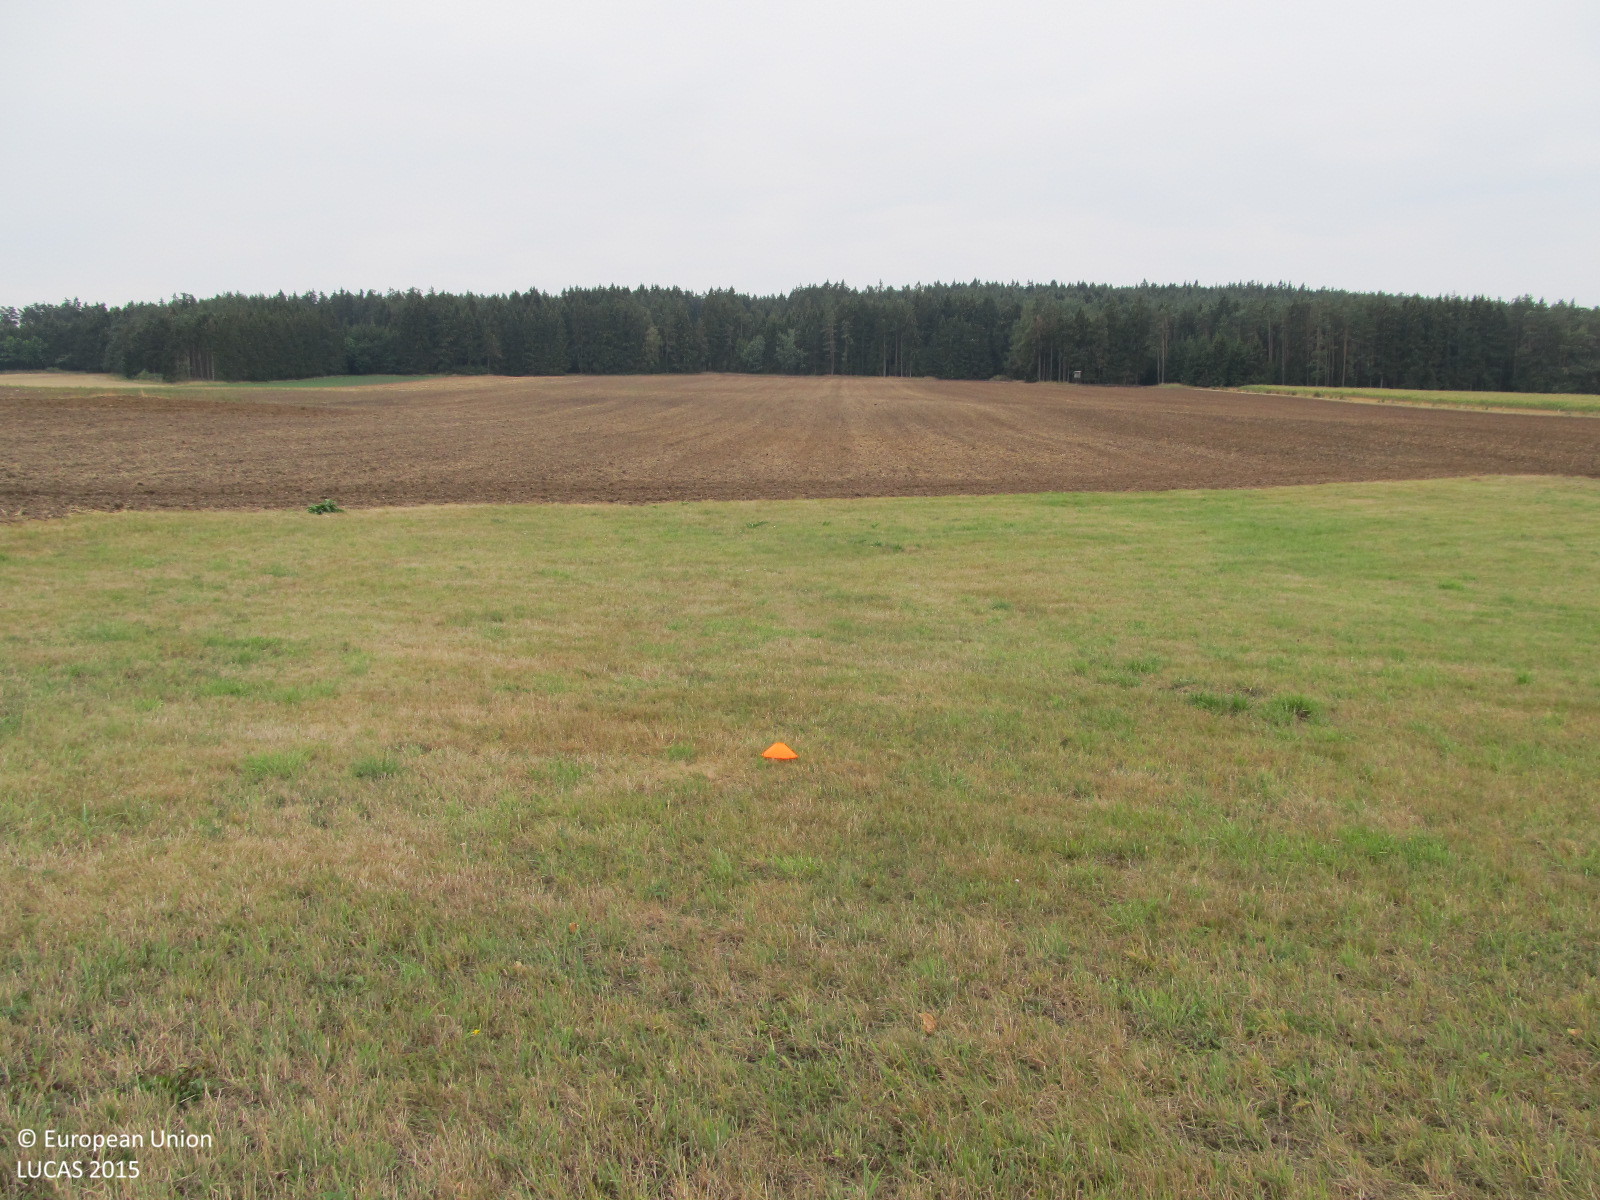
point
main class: Grassland
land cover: Grassland without tree/shrub cover
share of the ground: > 75 %
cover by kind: herbaceous plants 100 %
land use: Agriculture (excluding fallow land and kitchen gardens)
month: August
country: AT
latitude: 48.9363
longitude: 15.4501
